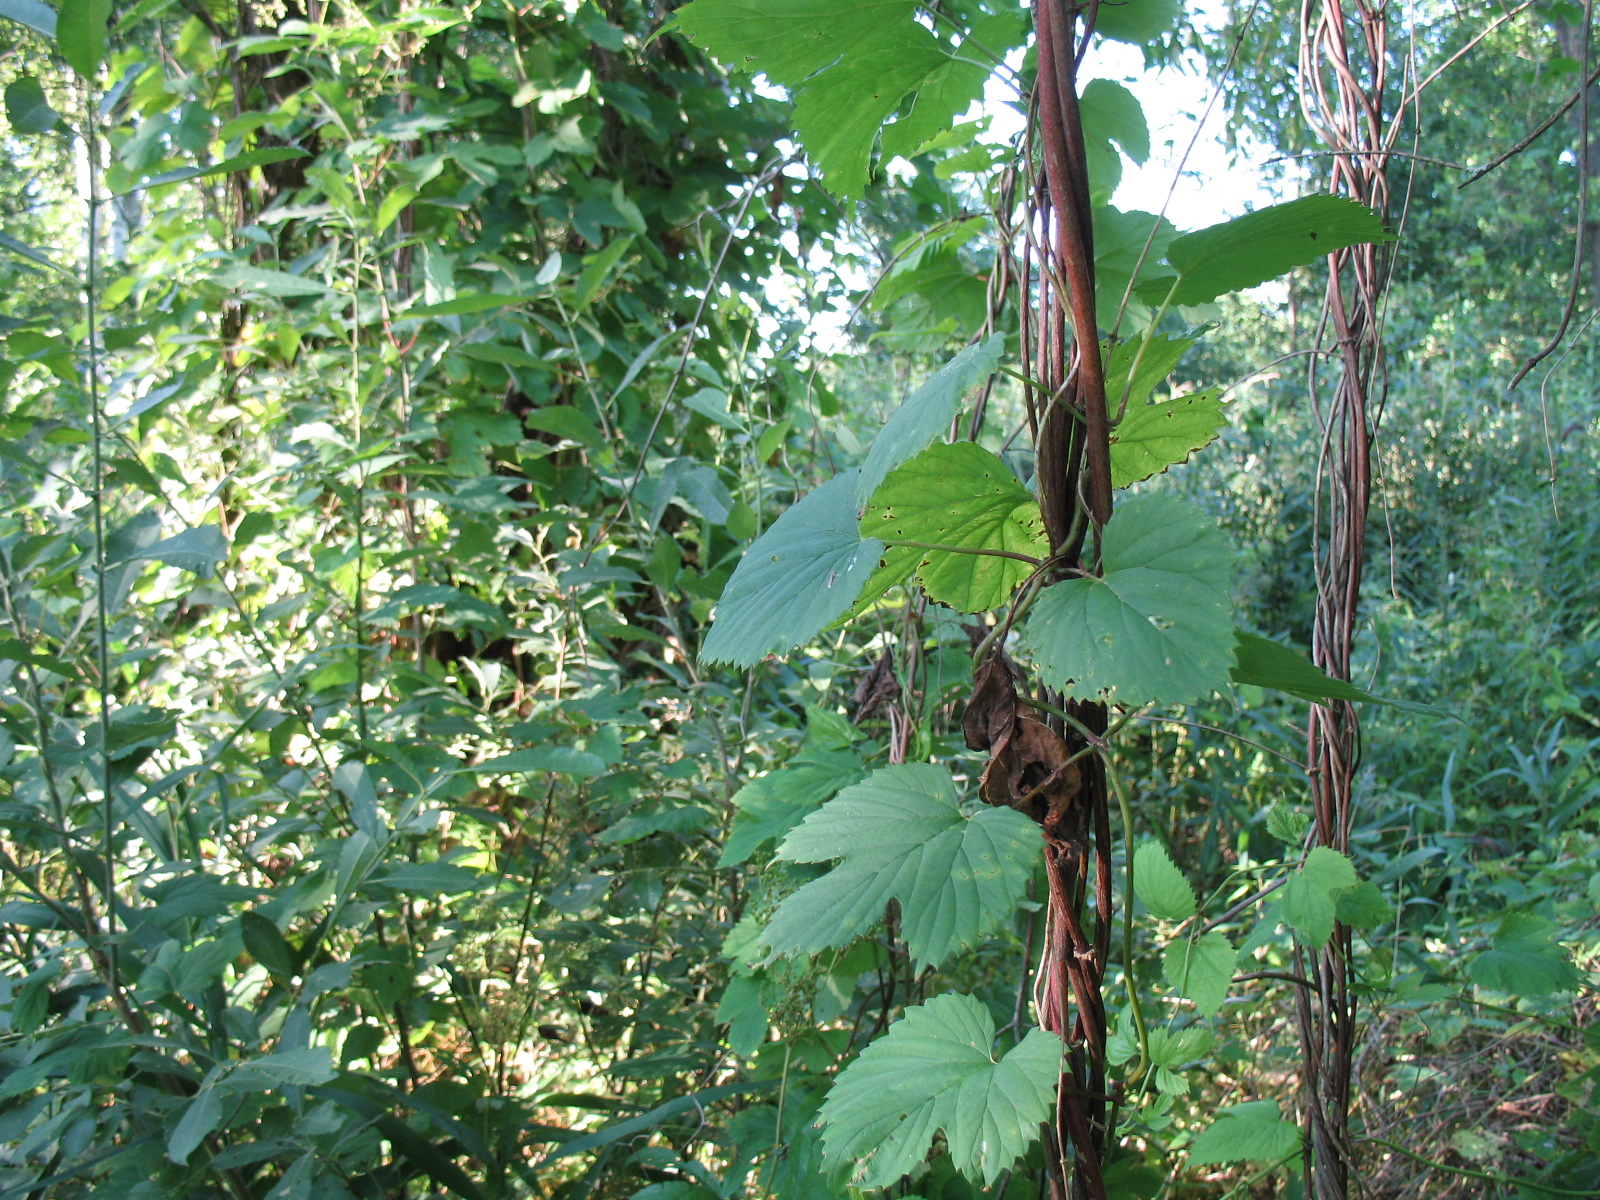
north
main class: Woodland
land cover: Broadleaved woodland
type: mire and swamp forests
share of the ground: 25 - 50 %
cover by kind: broadleaved forest trees 40 %, shrubs 30 %, herbaceous plants 30 %
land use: Forestry
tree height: > 5 m
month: August
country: LV
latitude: 56.4813
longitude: 25.2303
